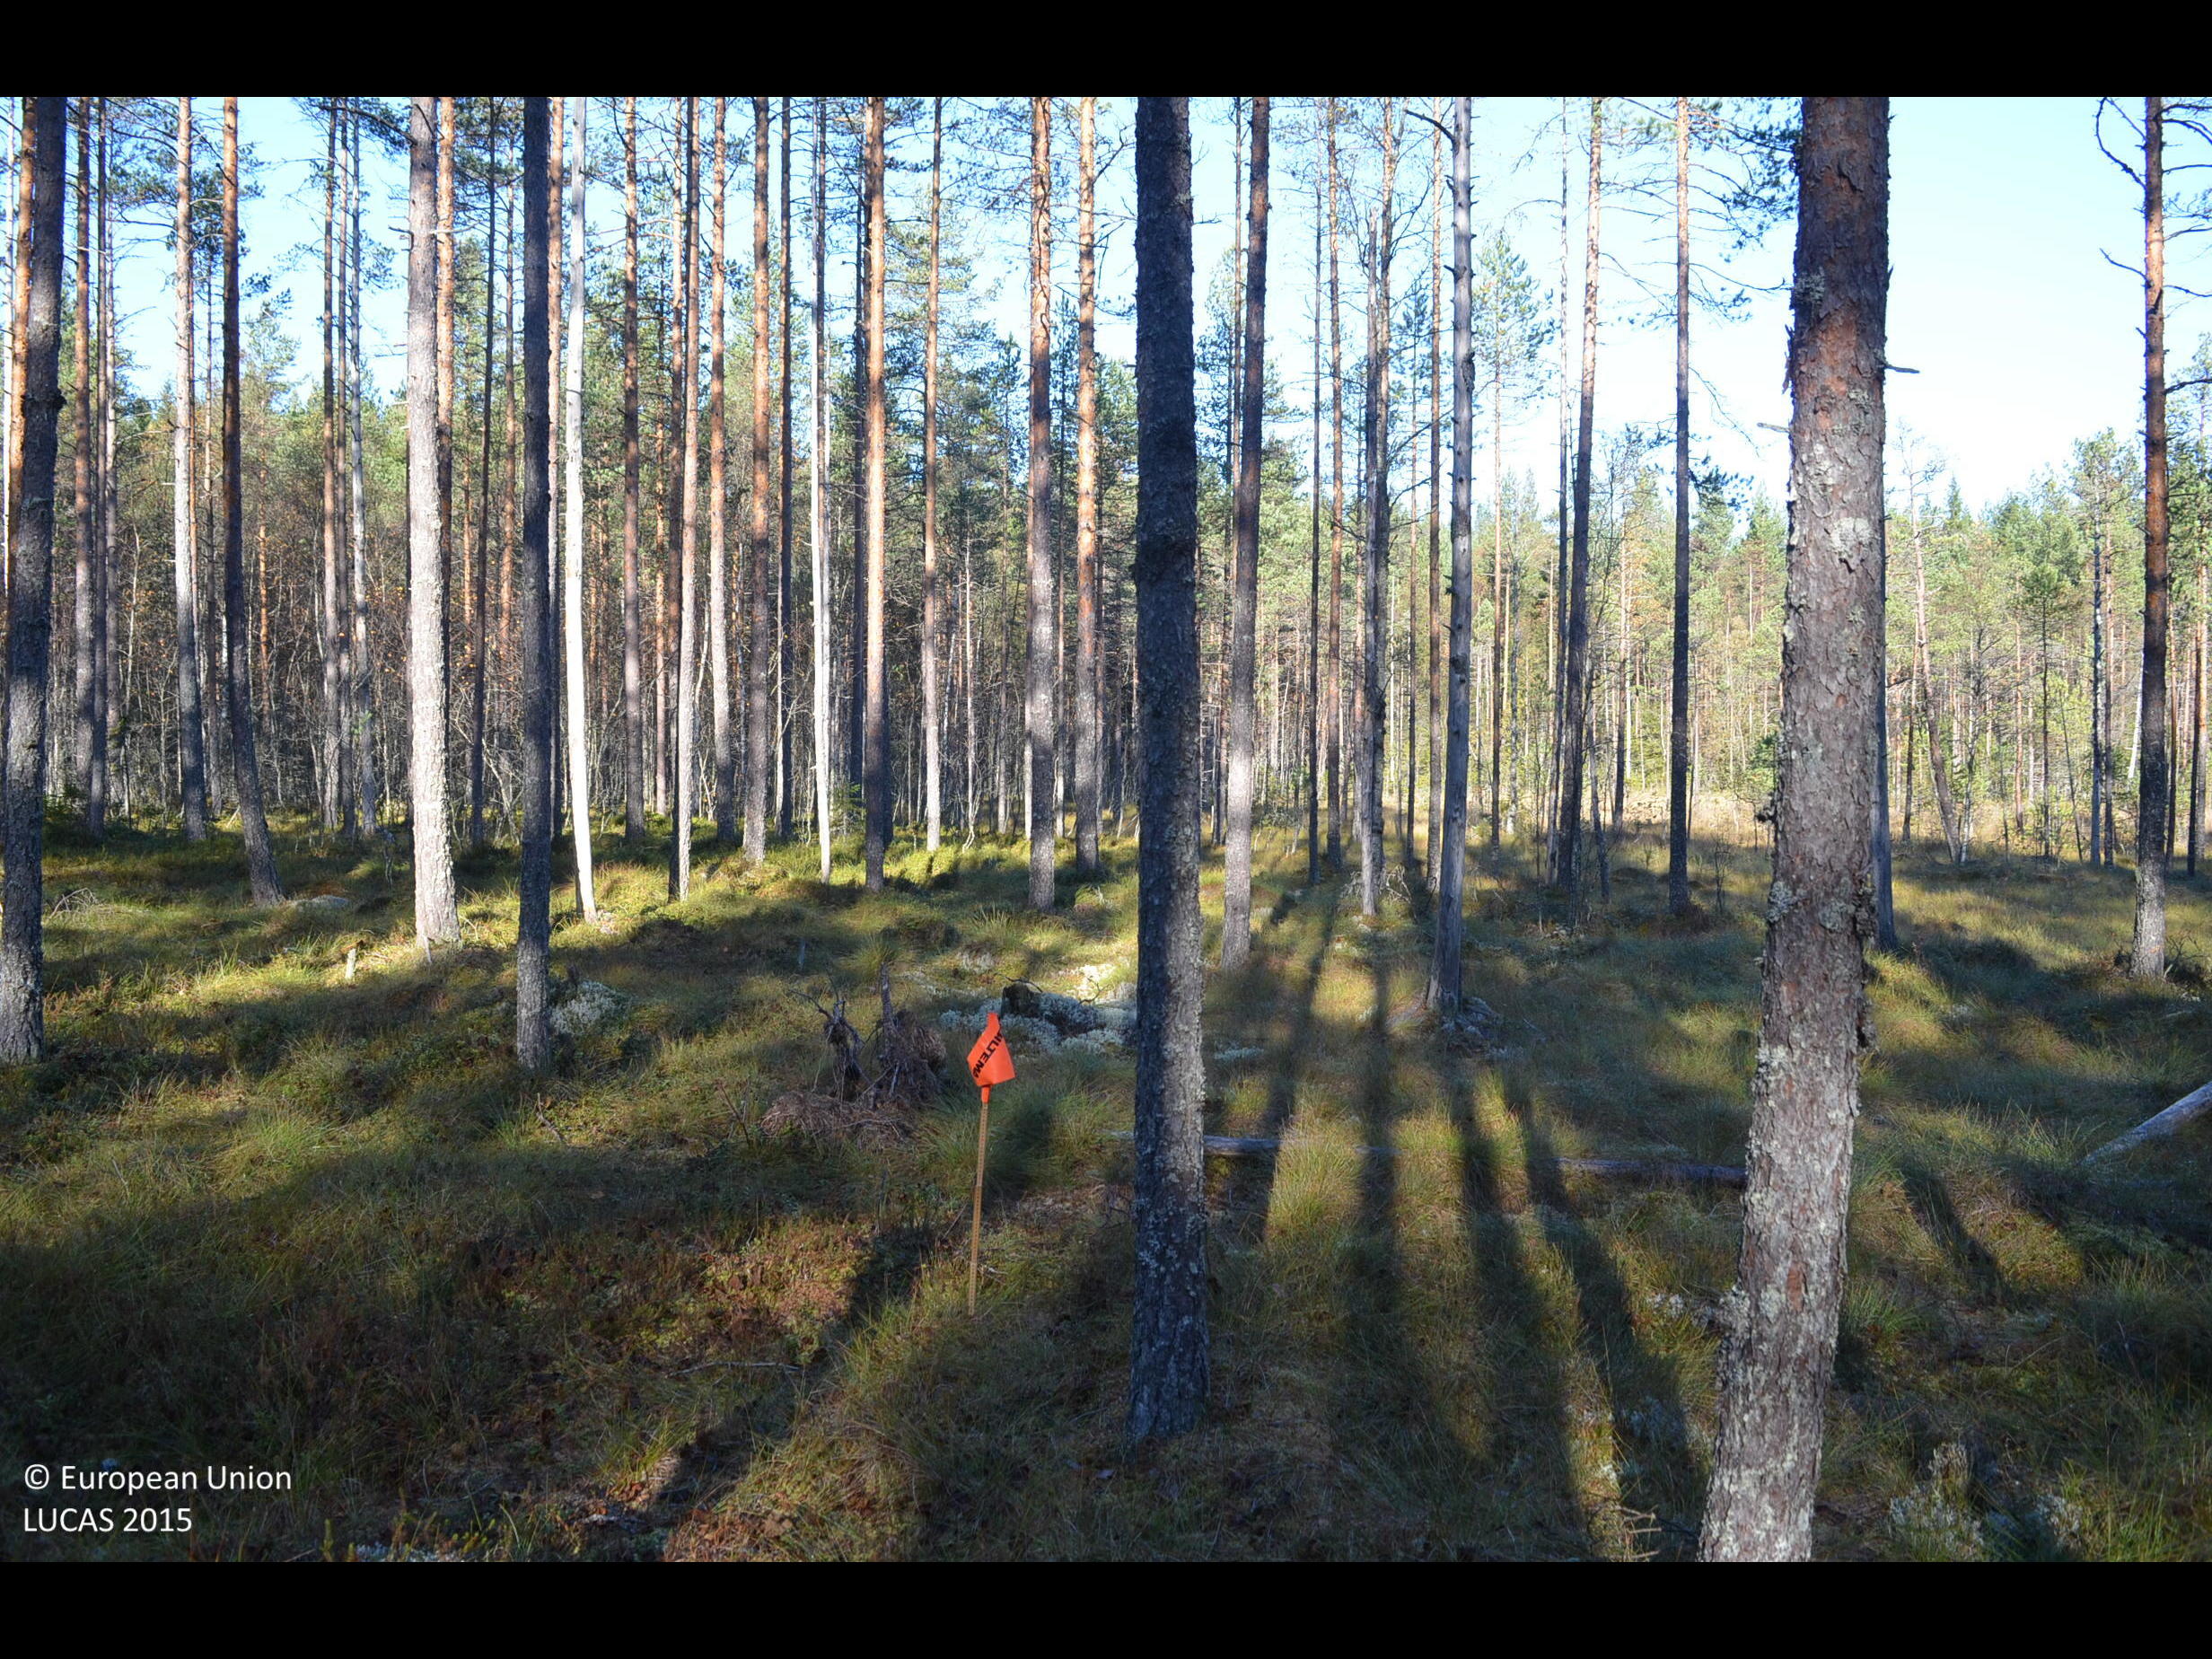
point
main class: Woodland
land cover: Pine dominated coniferous woodland
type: boreal forest
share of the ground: 50 - 75 %
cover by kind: coniferous forest trees 60 %, shrubs 15 %, lichens and mosses 15 %, herbaceous plants 10 %
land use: Forestry
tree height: > 5 m
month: October
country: FI
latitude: 61.7935
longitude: 23.9490
